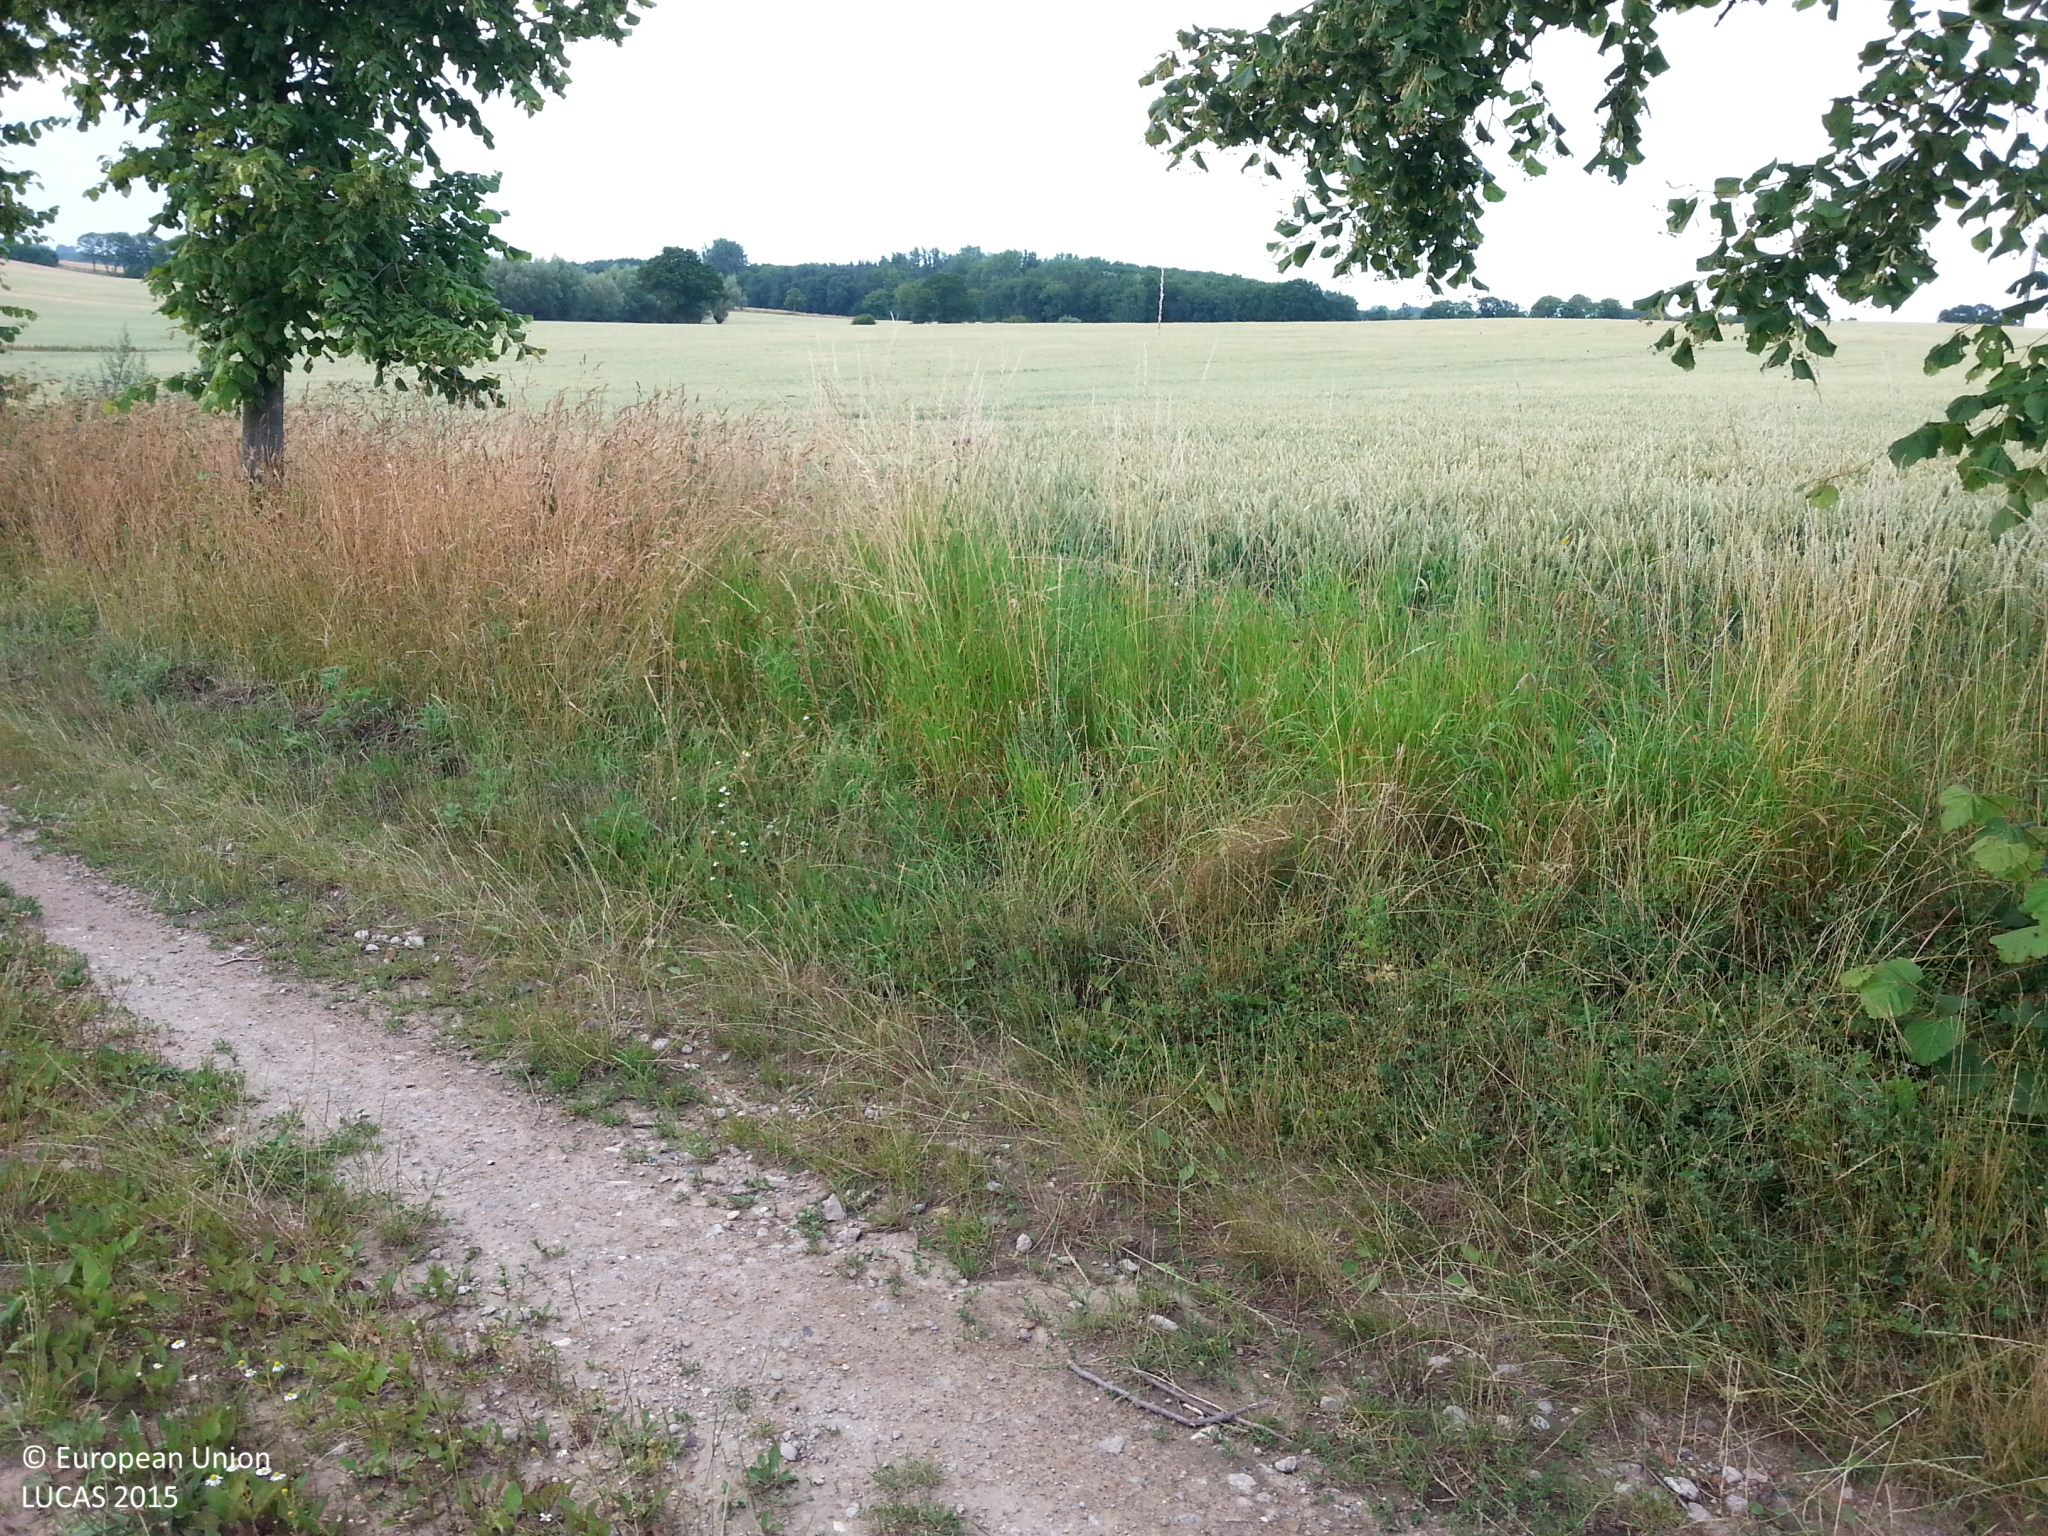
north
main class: Cropland
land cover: Rape and turnip rape
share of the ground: > 75 %
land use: Agriculture (excluding fallow land and kitchen gardens)
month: July
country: DE
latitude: 53.9717
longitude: 11.1428
